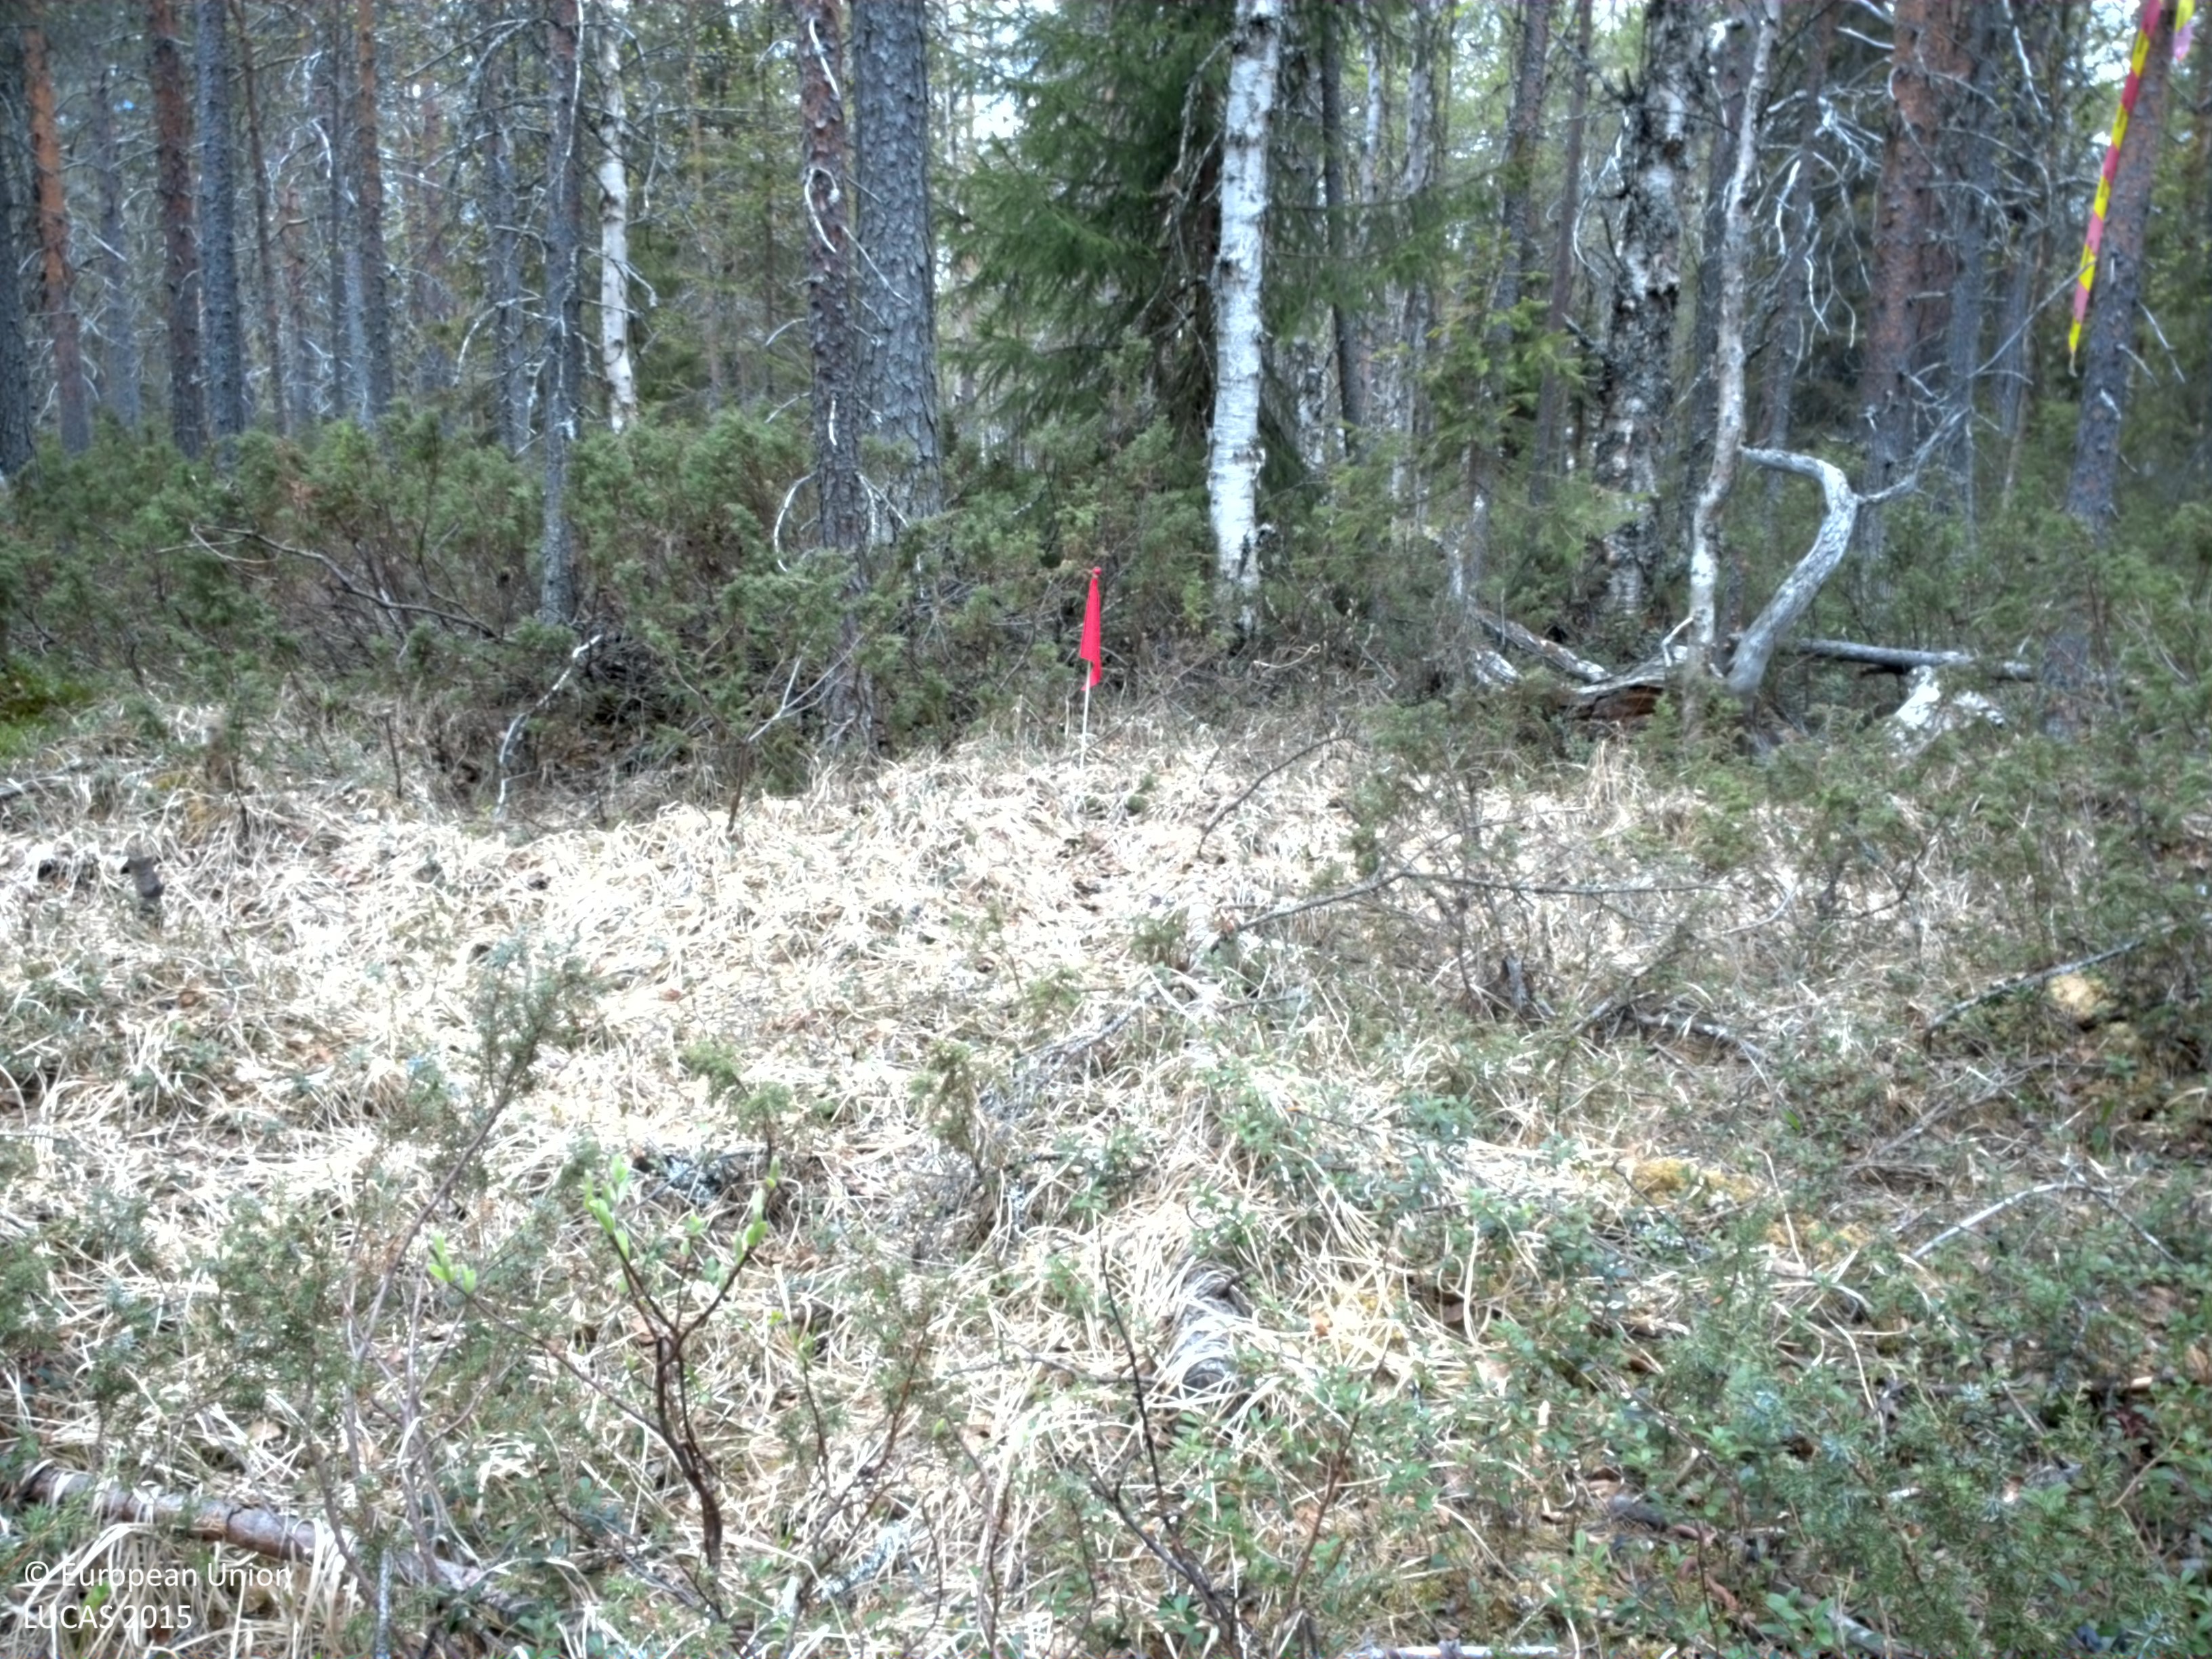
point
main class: Woodland
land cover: Pine dominated coniferous woodland
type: boreal forest
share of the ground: 50 - 75 %
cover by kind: coniferous forest trees 50 %, shrubs 35 %, herbaceous plants 10 %, broadleaved forest trees 5 %
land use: Forestry
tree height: > 5 m
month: June
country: SE
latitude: 66.0868
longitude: 18.7322
